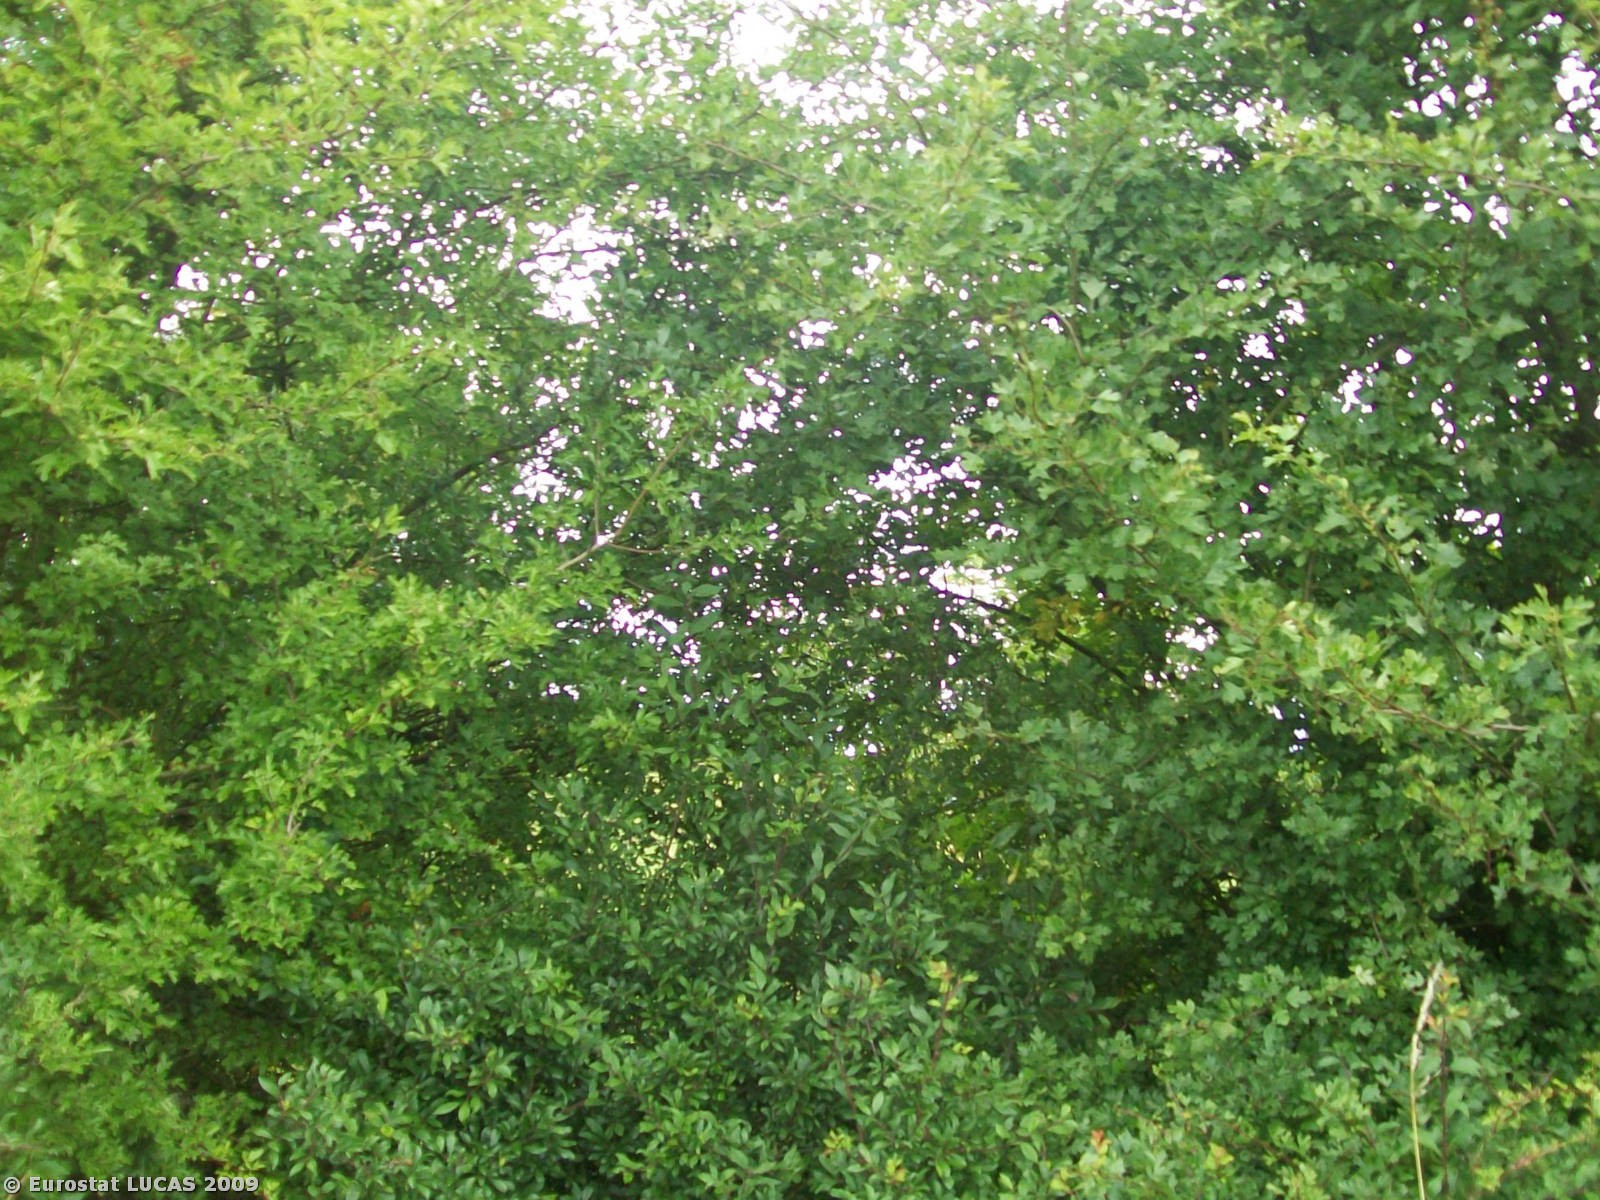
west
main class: Grassland
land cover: Grassland without tree/shrub cover
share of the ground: > 75 %
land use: Agriculture (excluding fallow land and kitchen gardens)
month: July
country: GB
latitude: 51.9615
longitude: 0.0864
